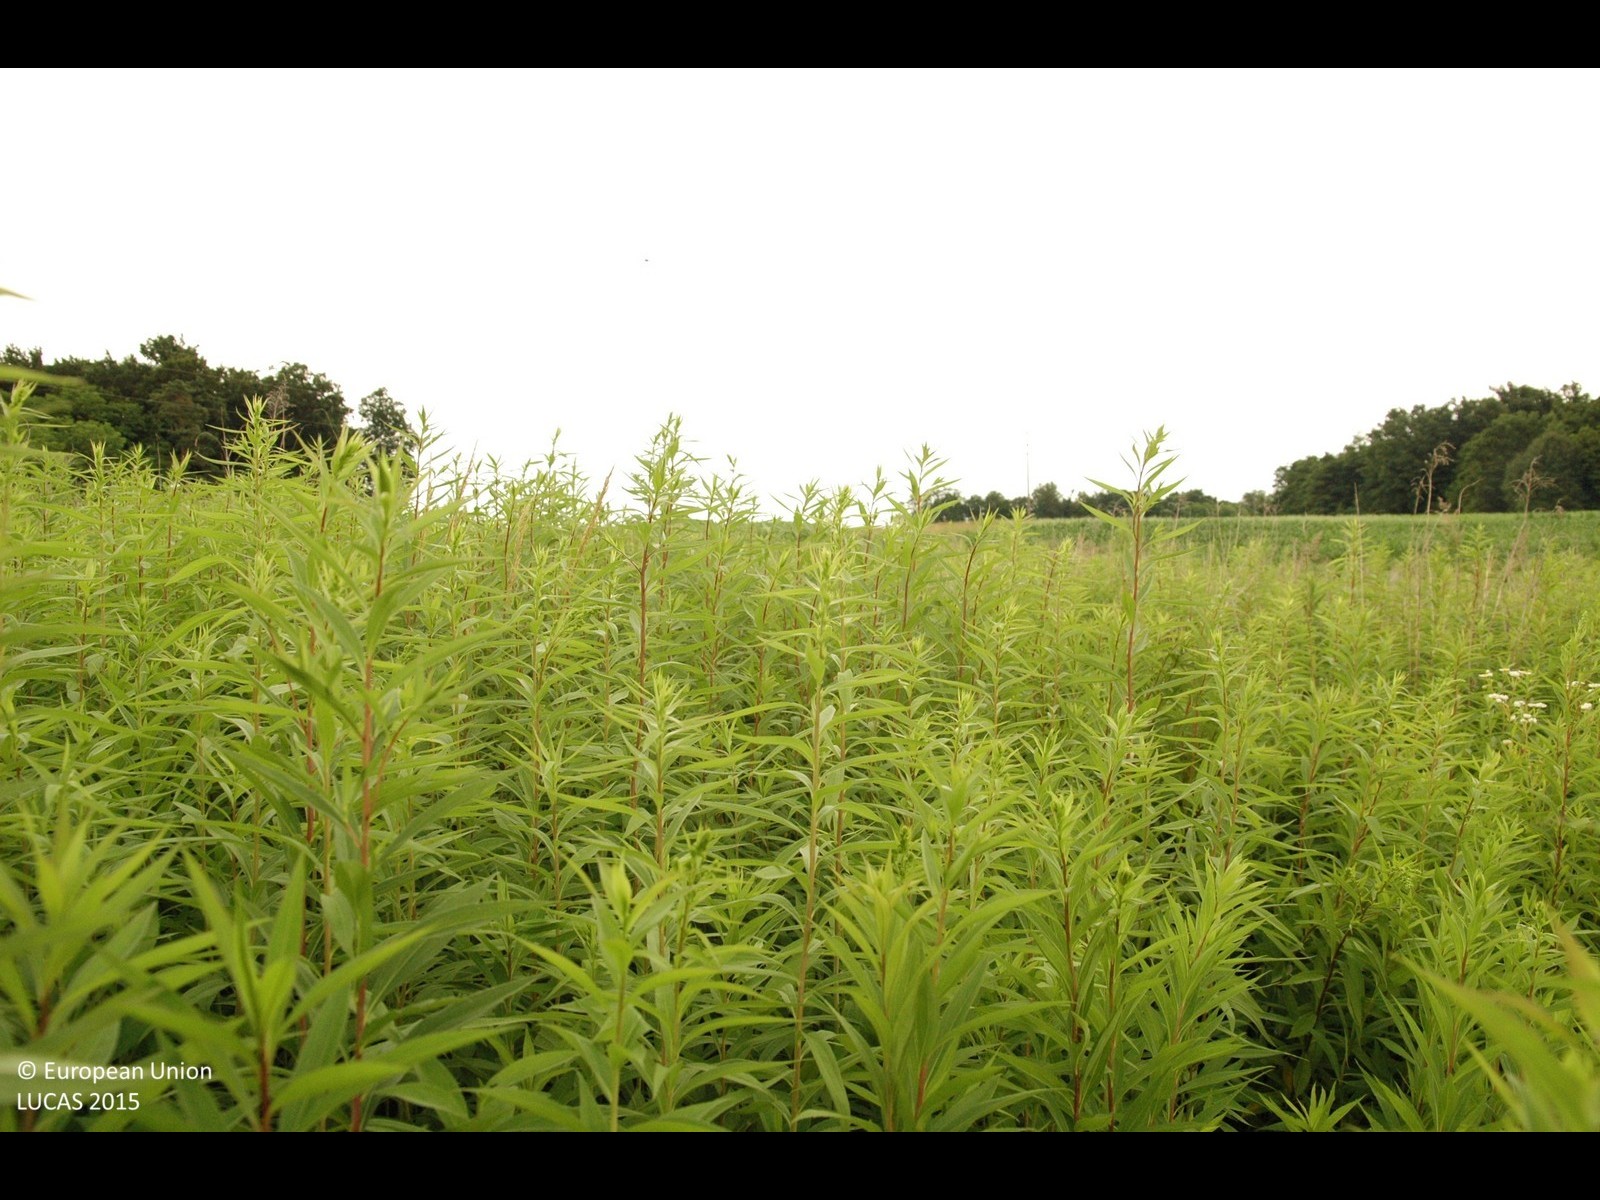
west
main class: Grassland
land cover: Spontaneously vegetated surfaces
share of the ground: > 75 %
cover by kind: herbaceous plants 95 %, shrubs 5 %
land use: Agriculture (excluding fallow land and kitchen gardens)
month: June
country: HR
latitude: 46.4162
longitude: 16.3364
